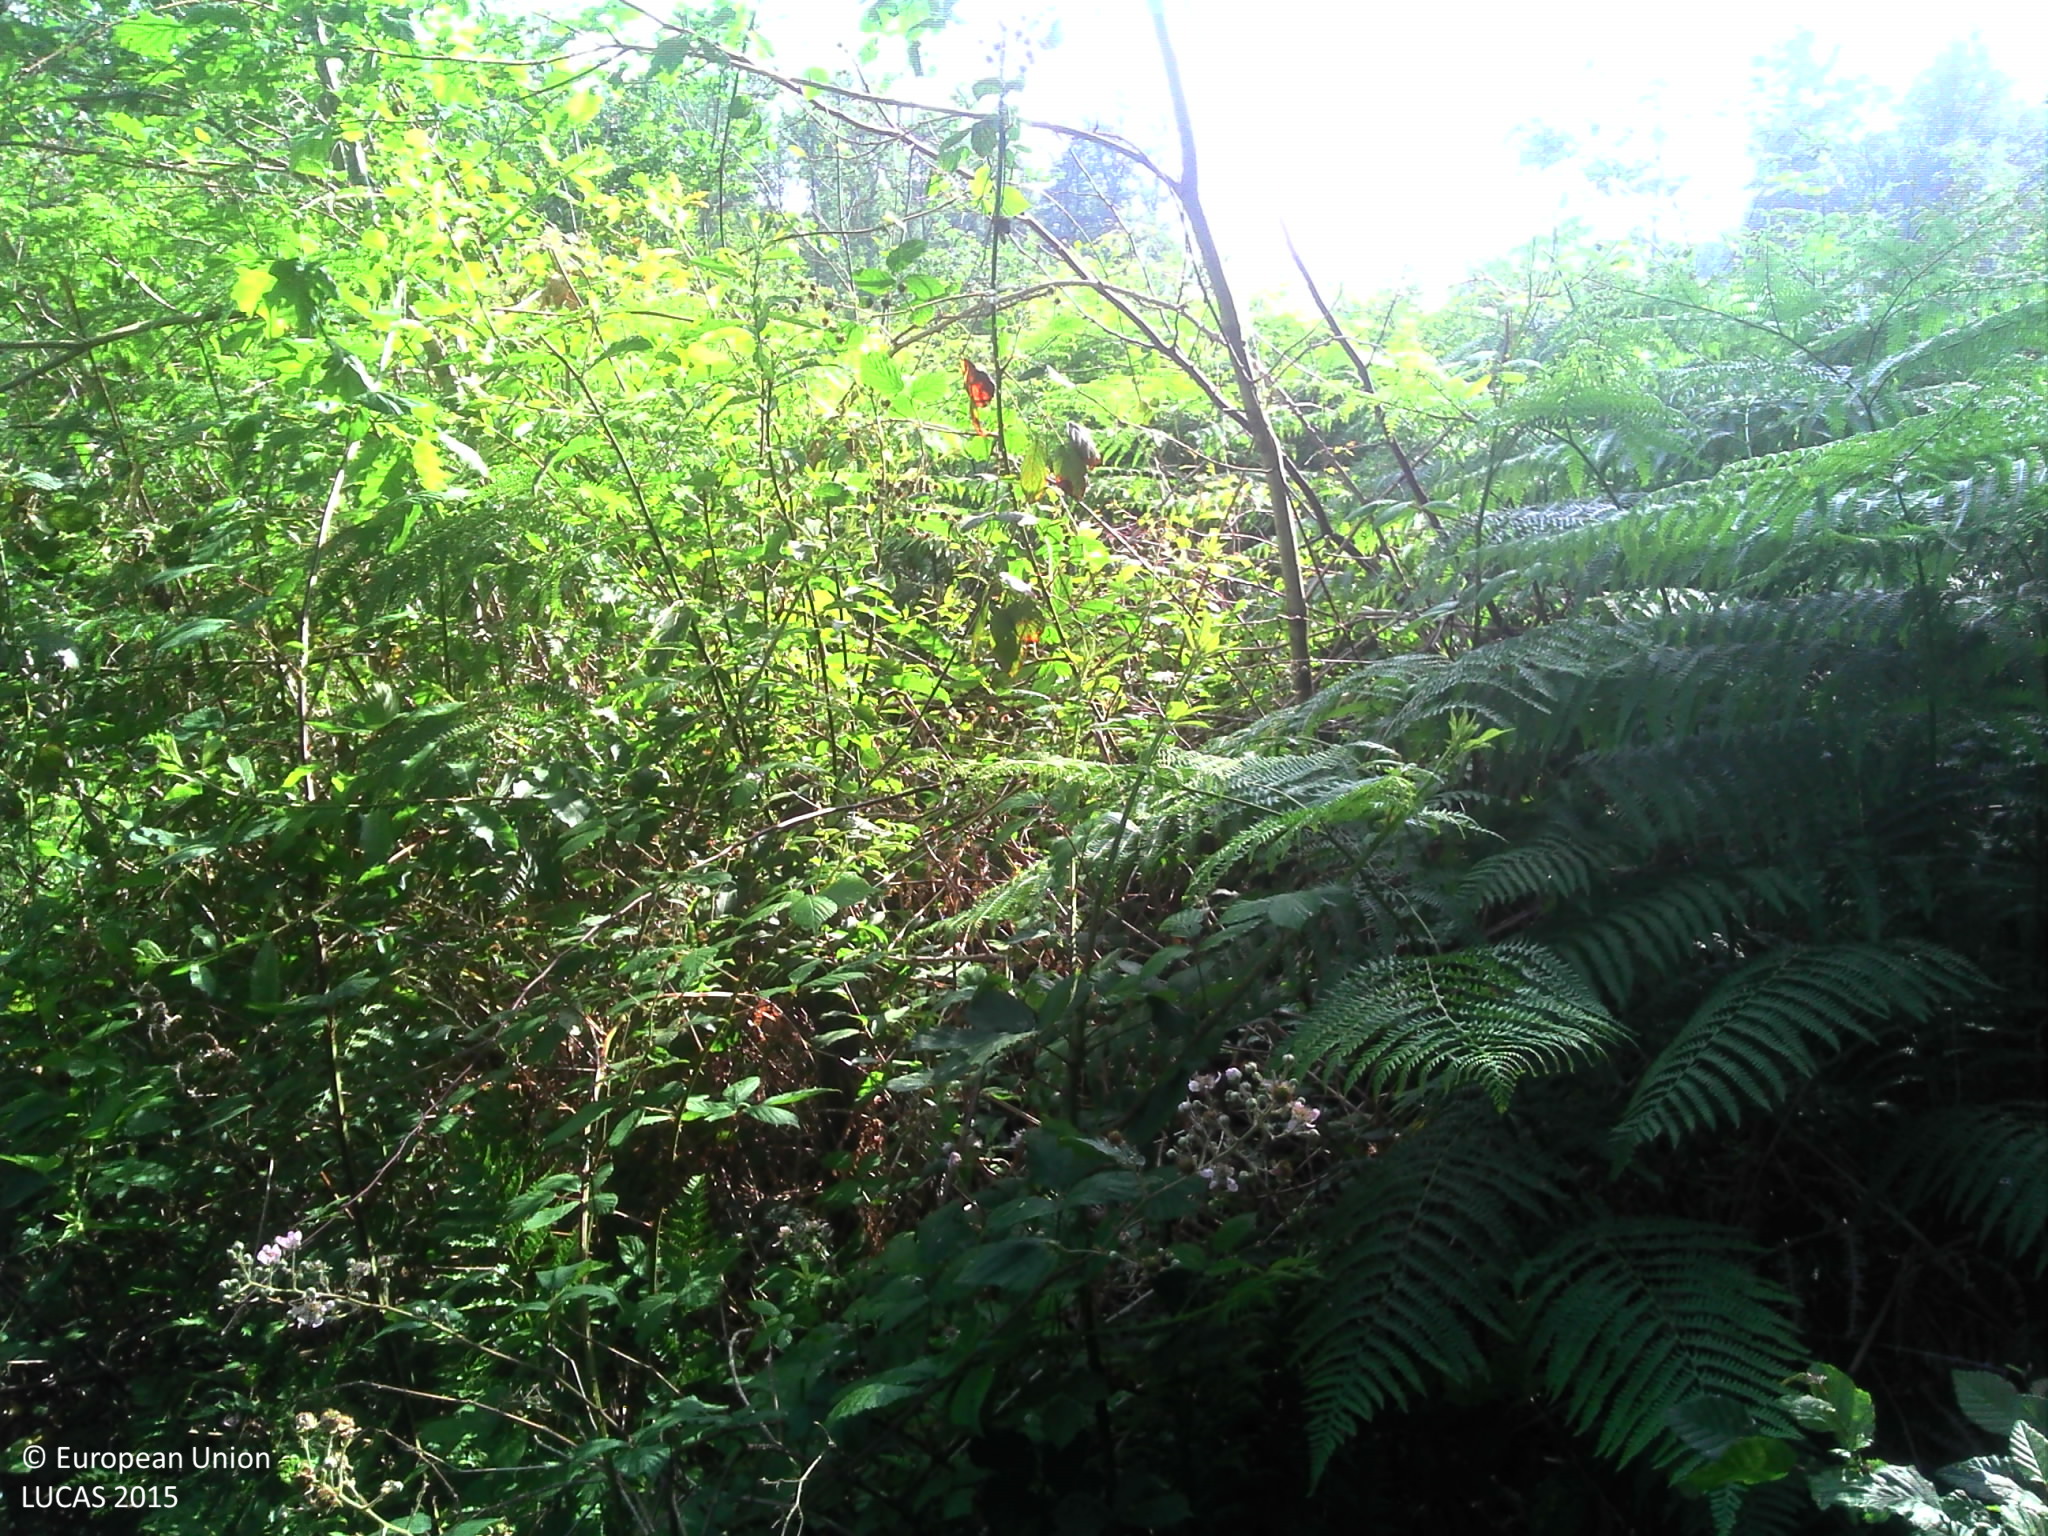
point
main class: Woodland
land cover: Broadleaved woodland
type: mesophytic deciduous forest
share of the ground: > 75 %
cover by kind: herbaceous plants 70 %, broadleaved forest trees 30 %
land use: Forestry
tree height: > 5 m
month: June
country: FR
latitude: 47.5560
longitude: 1.3335
